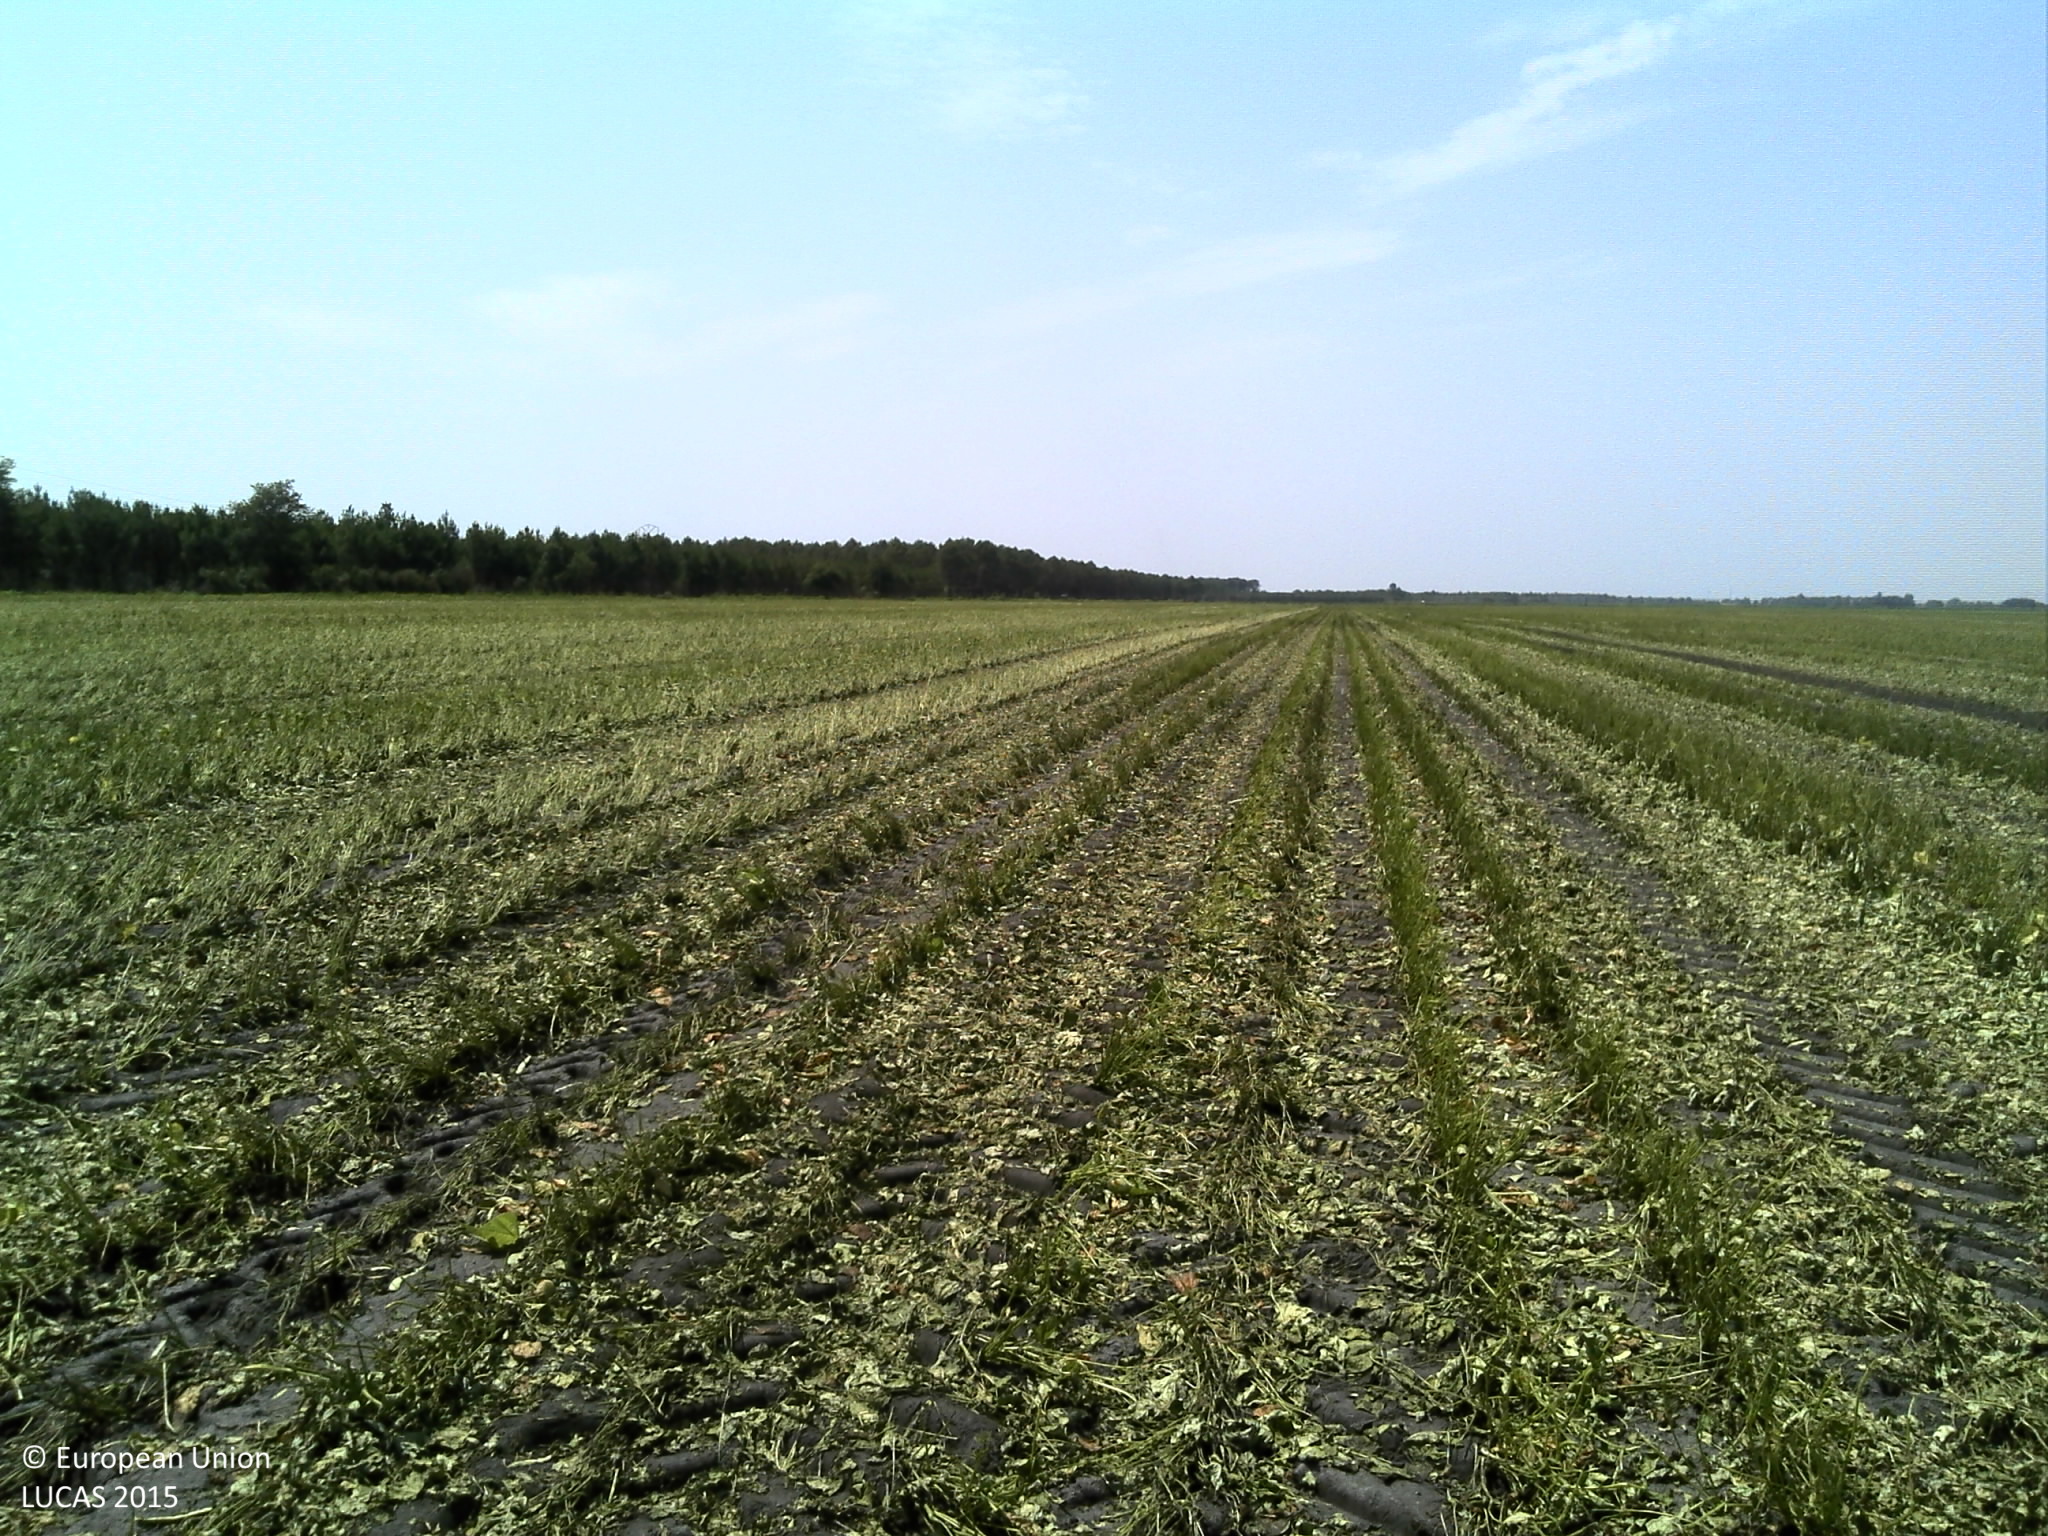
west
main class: Cropland
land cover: Dry pulses
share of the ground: < 10 %
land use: Agriculture (excluding fallow land and kitchen gardens)
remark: Harvested field
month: July
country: FR
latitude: 44.6706
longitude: -0.6771
